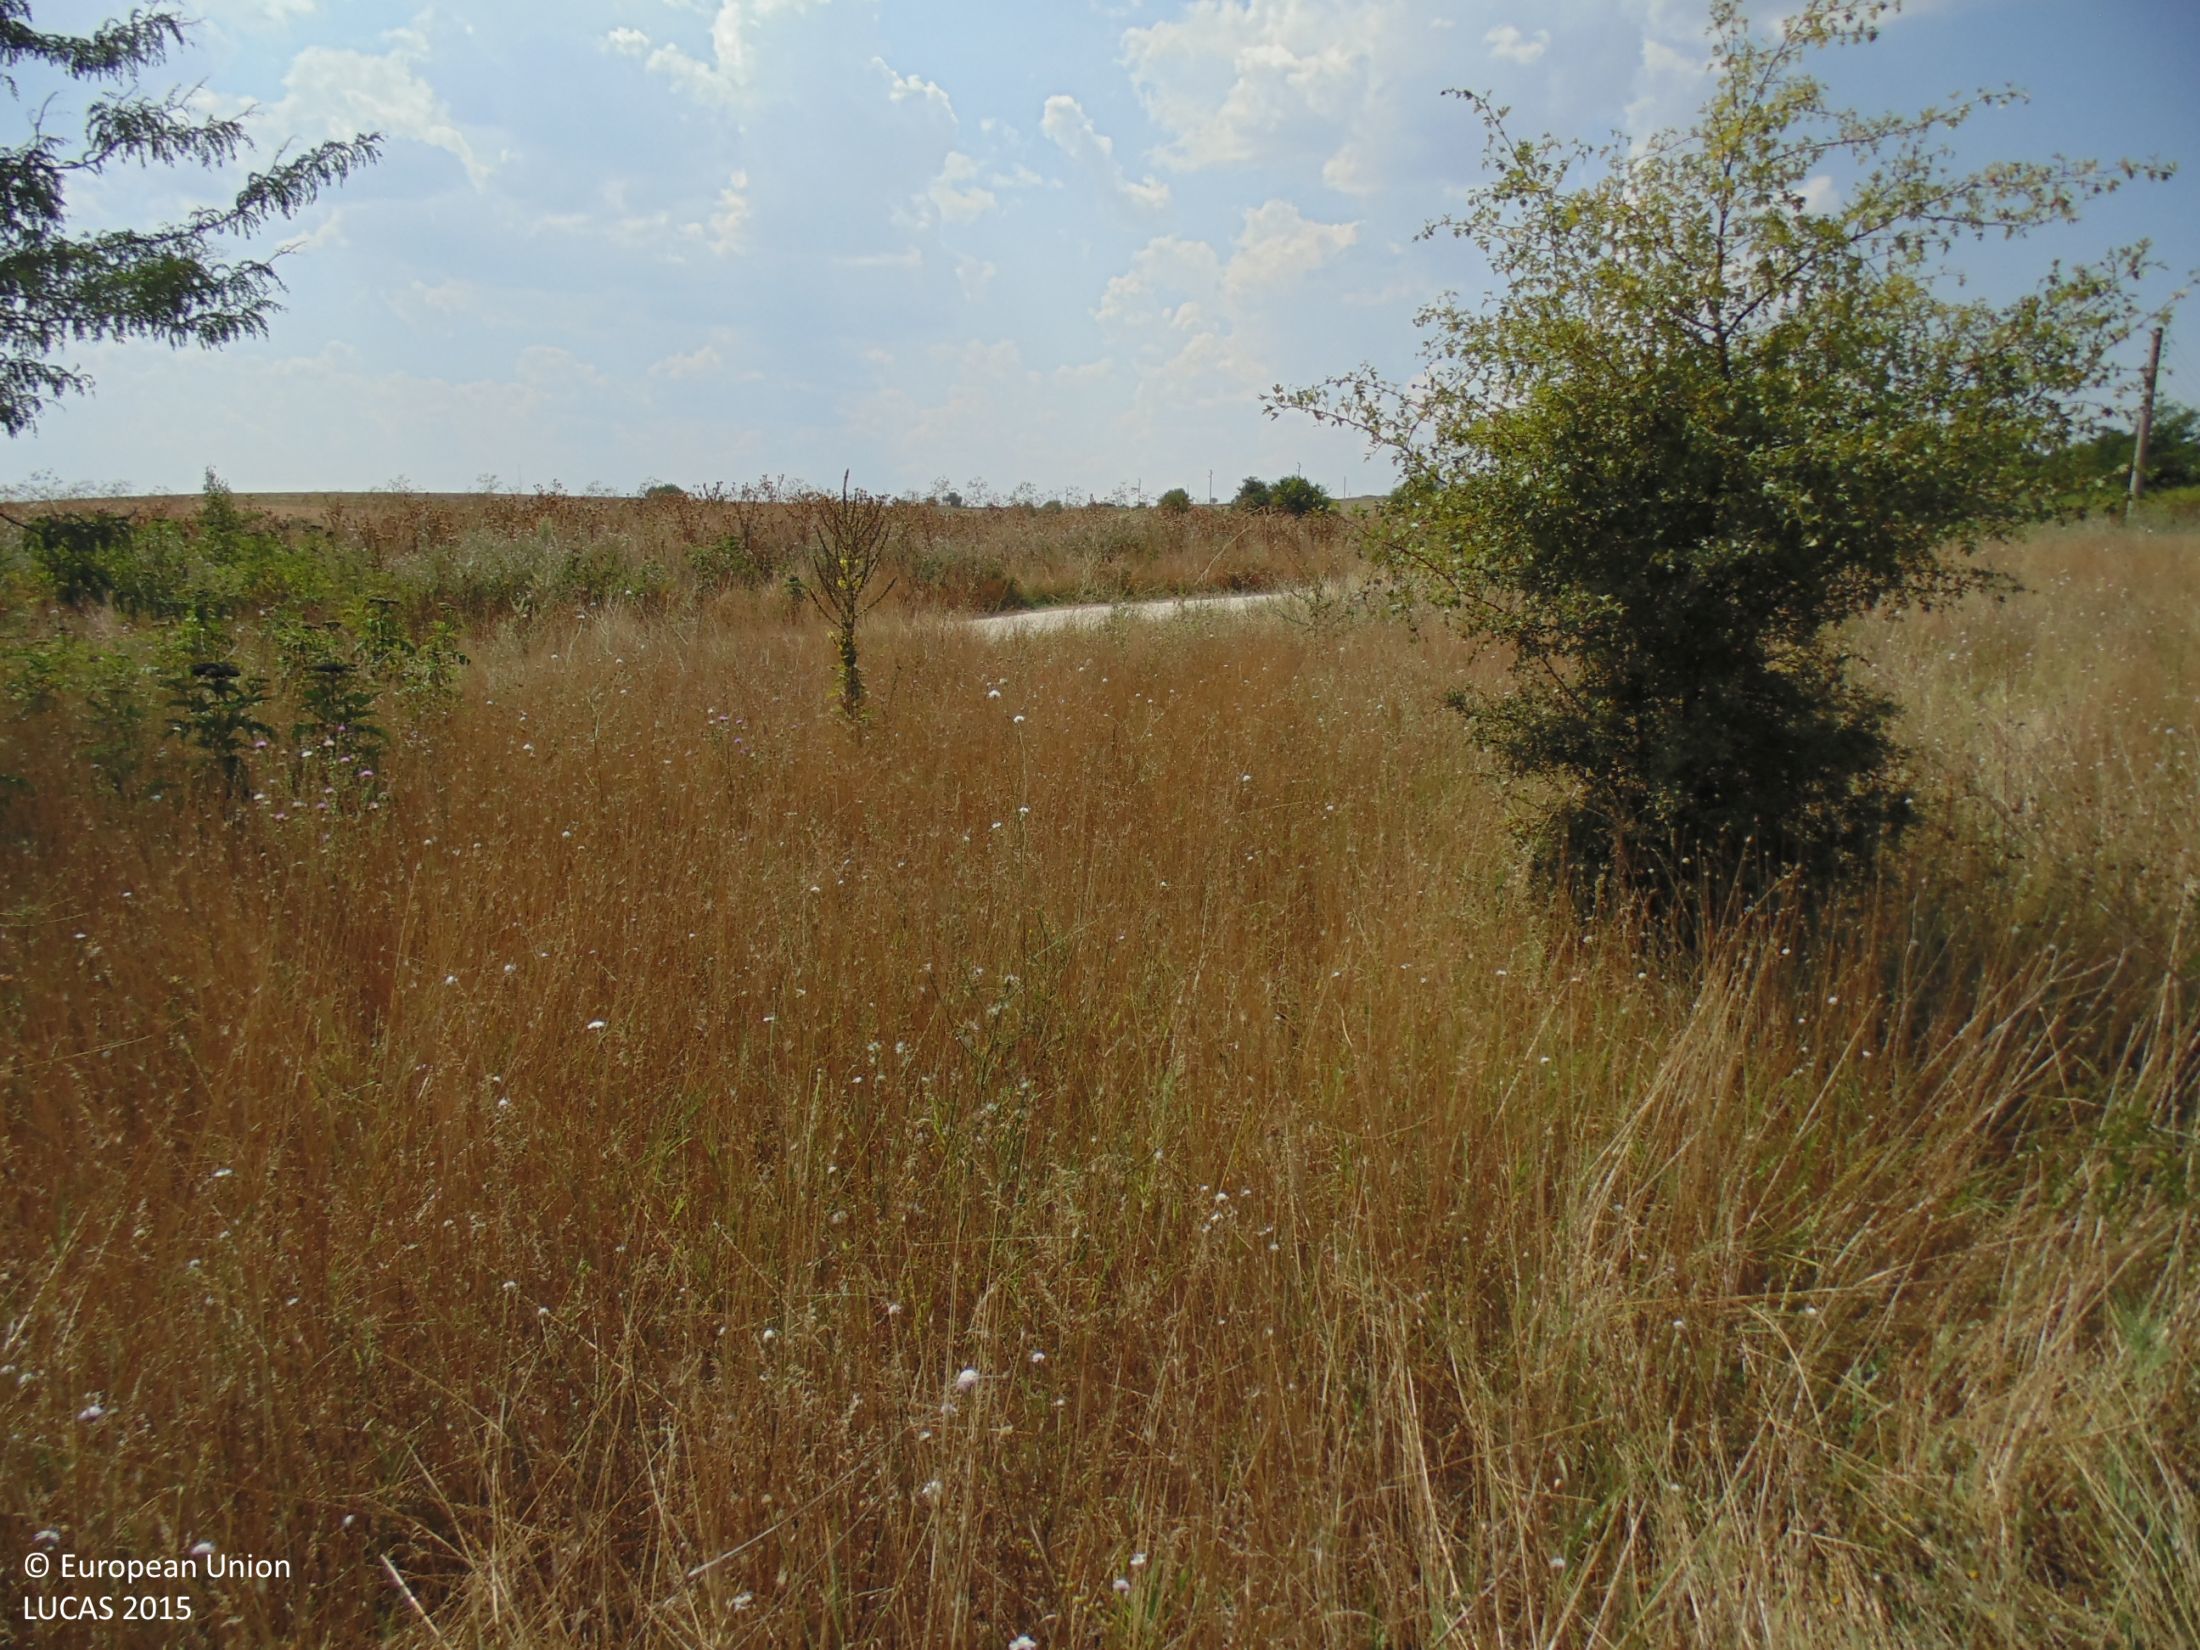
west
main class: Grassland
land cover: Grassland with sparse tree/shrub cover
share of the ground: > 75 %
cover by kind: herbaceous plants 90 %, broadleaved forest trees 5 %, shrubs 5 %
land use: Agriculture (excluding fallow land and kitchen gardens)
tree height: < 5 m
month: August
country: BG
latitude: 44.0043
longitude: 27.6391
